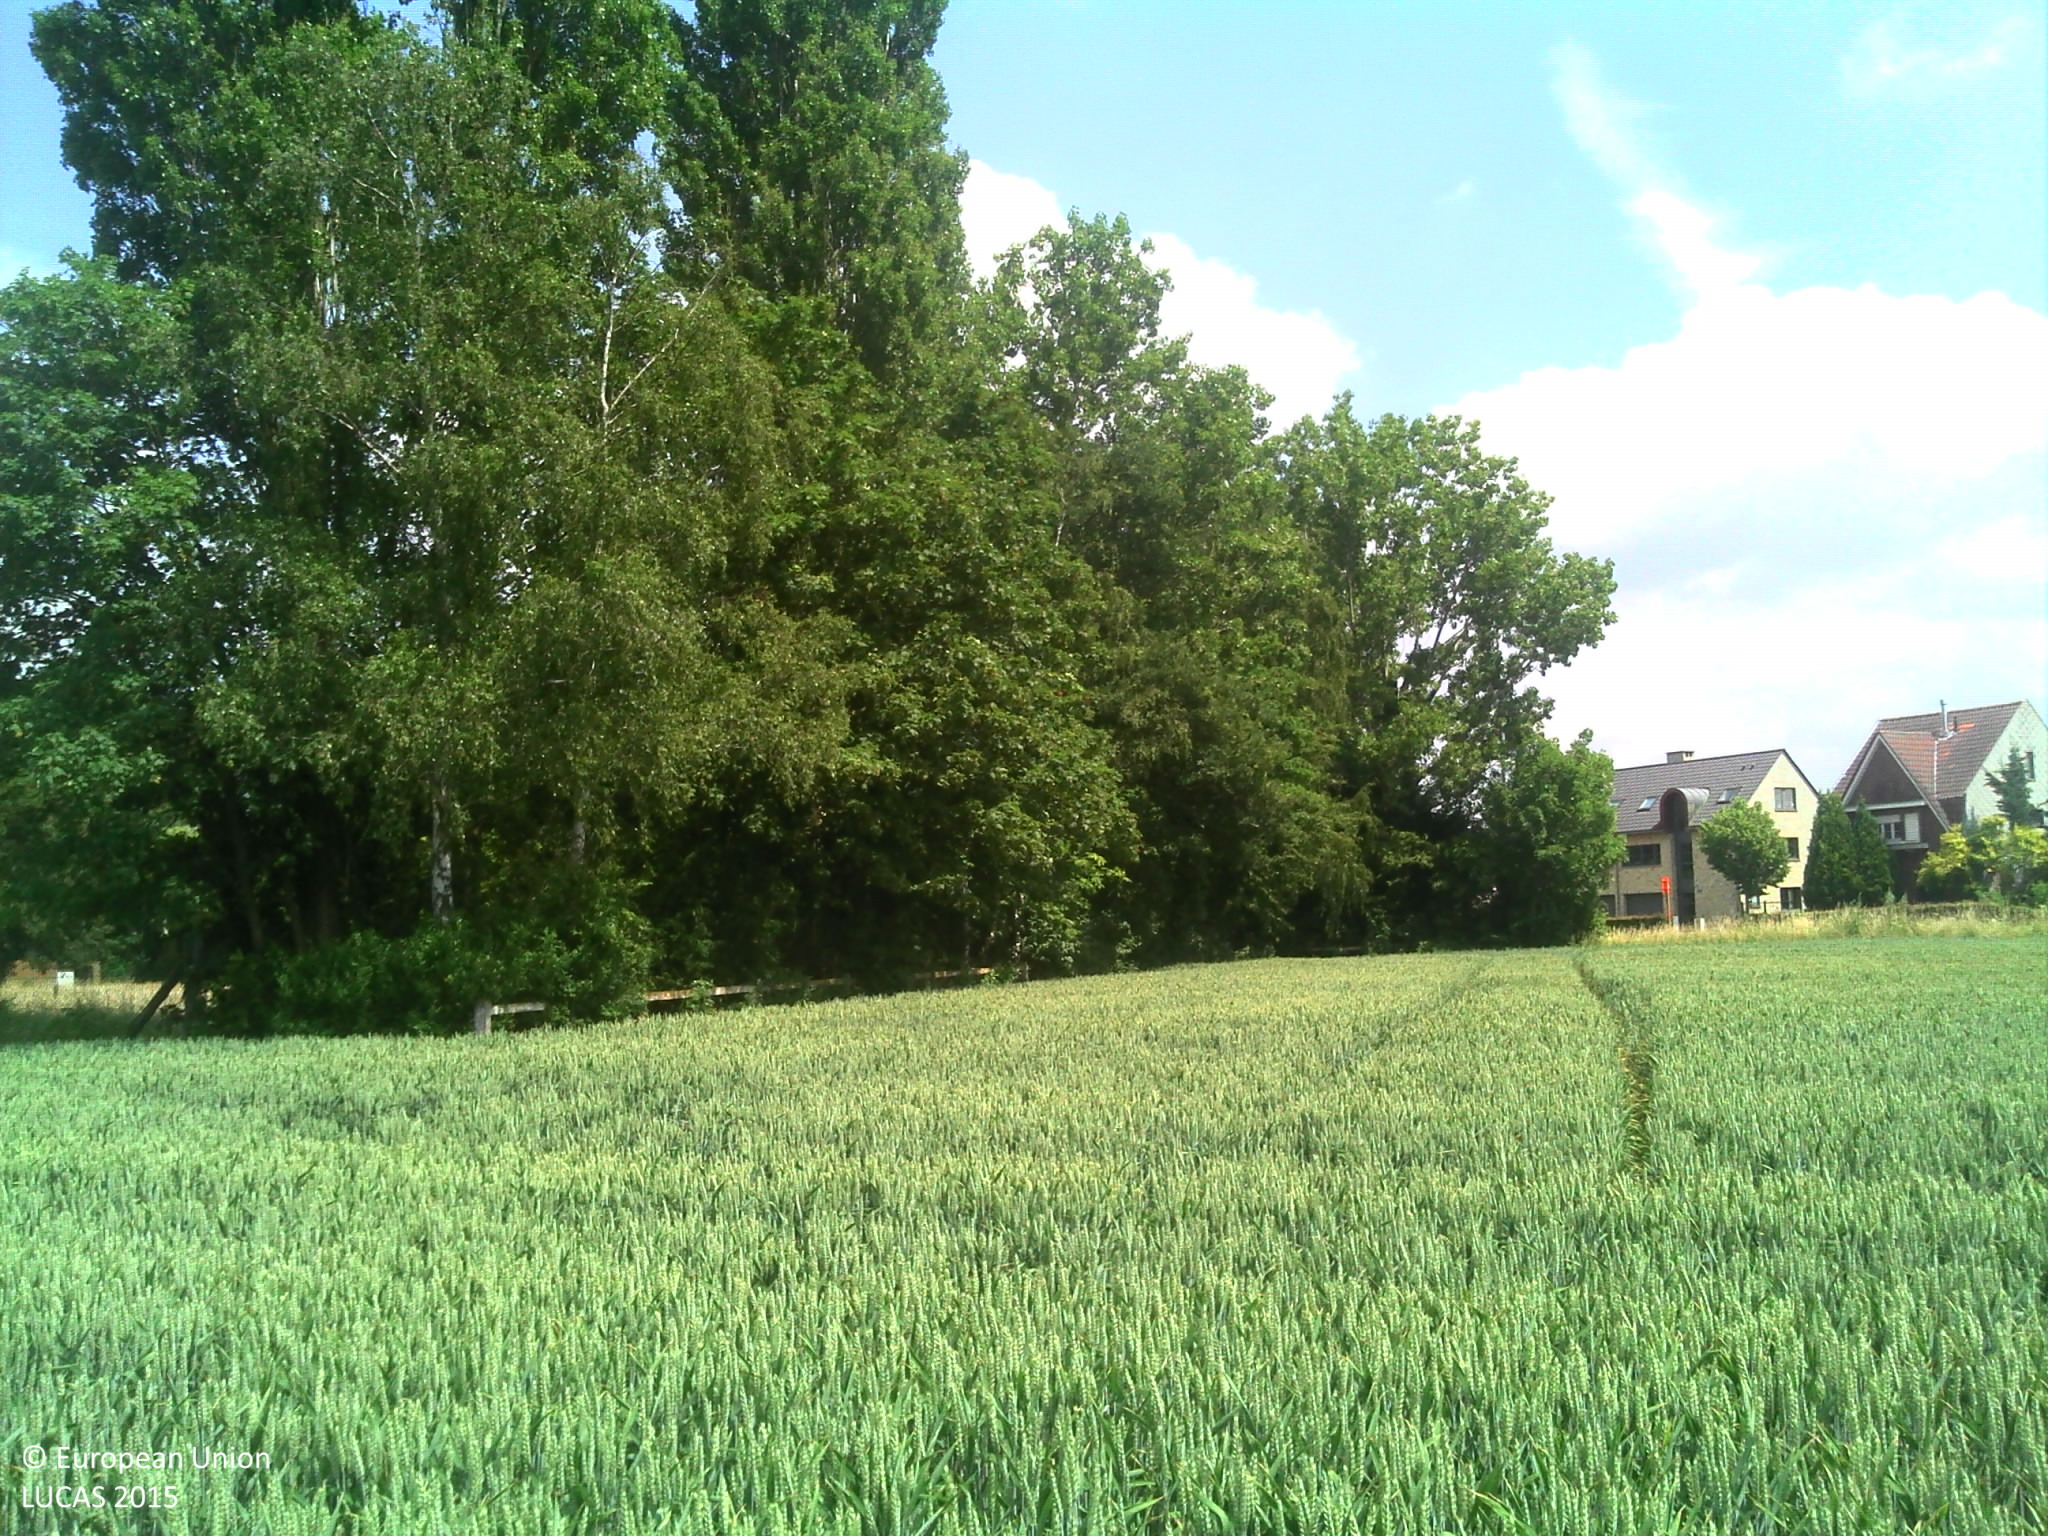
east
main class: Cropland
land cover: Common wheat
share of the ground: > 75 %
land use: Agriculture (excluding fallow land and kitchen gardens)
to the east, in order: Common wheat; Fences; Broadleaved woodland; Grassland without tree/shrub cover; Fences; Spruce dominated coniferous woodland; Artificial constructions in urban areas
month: June
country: BE
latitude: 50.9368
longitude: 4.5457
